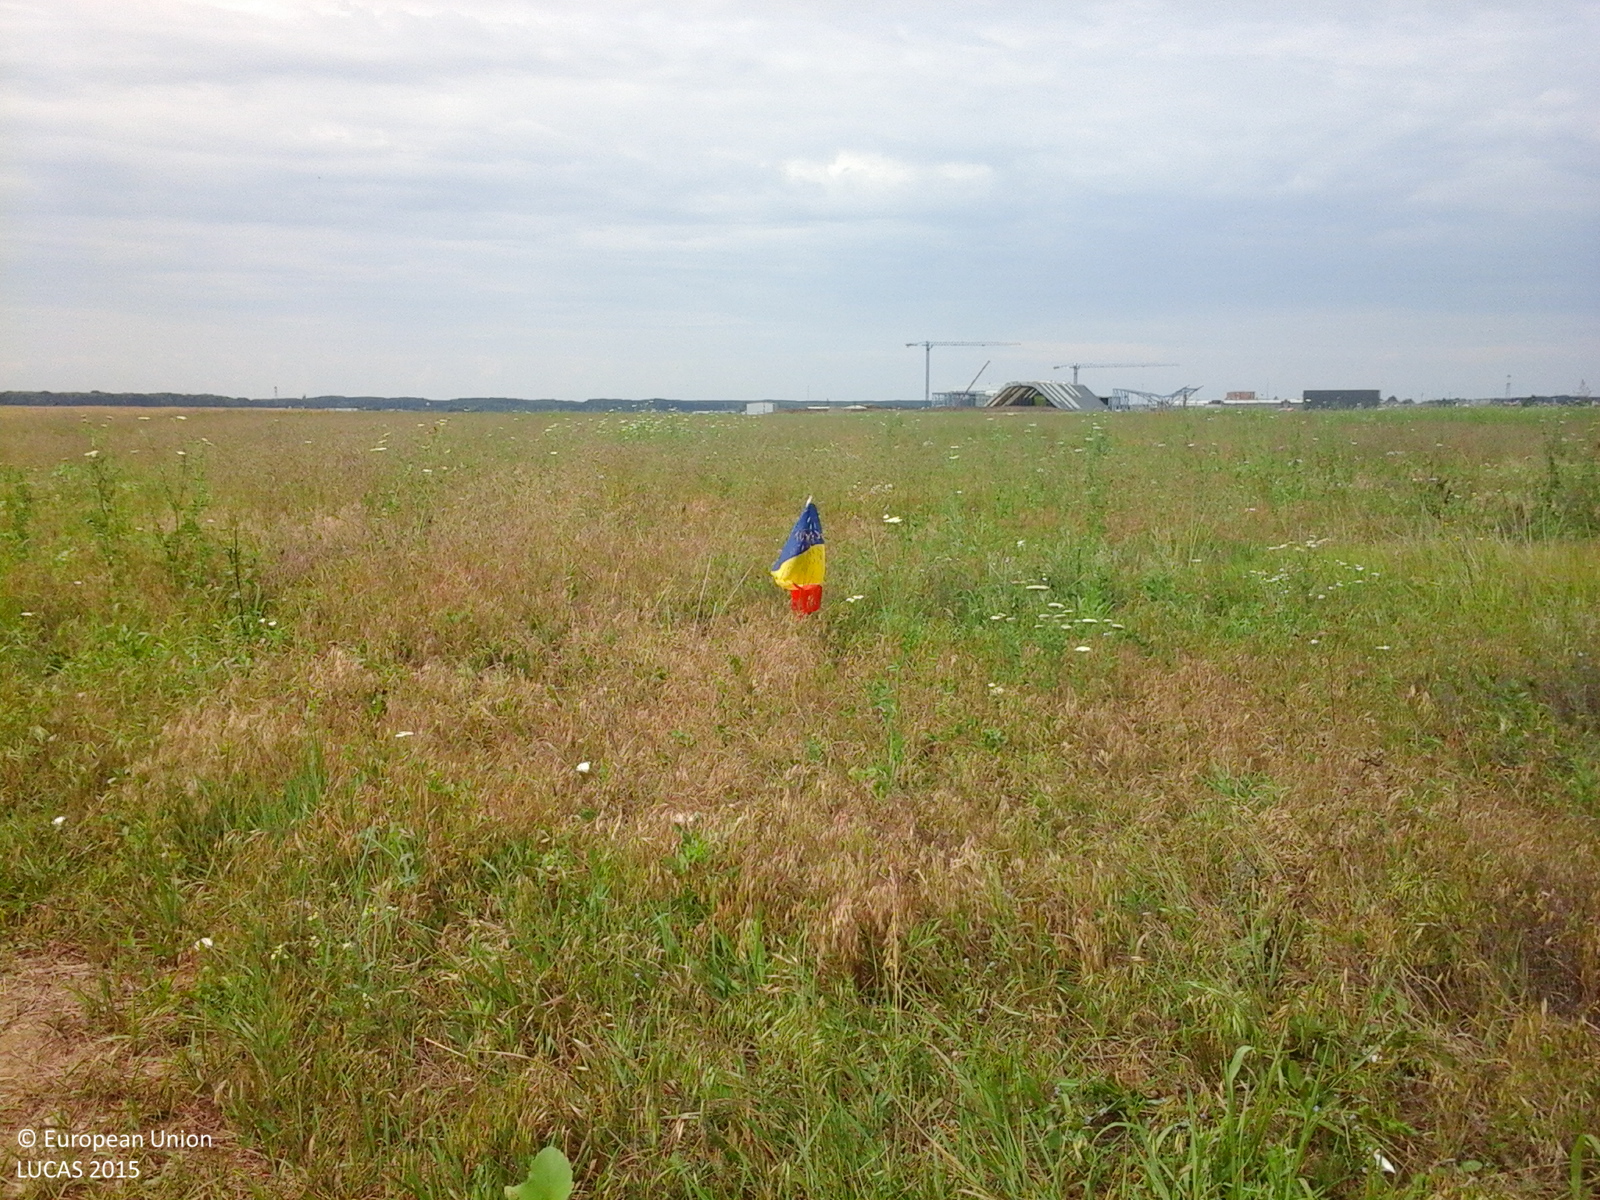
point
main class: Grassland
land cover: Grassland without tree/shrub cover
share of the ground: > 75 %
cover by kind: herbaceous plants 100 %
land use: Agriculture (excluding fallow land and kitchen gardens)
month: June
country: RO
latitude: 44.6080
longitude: 26.0964
